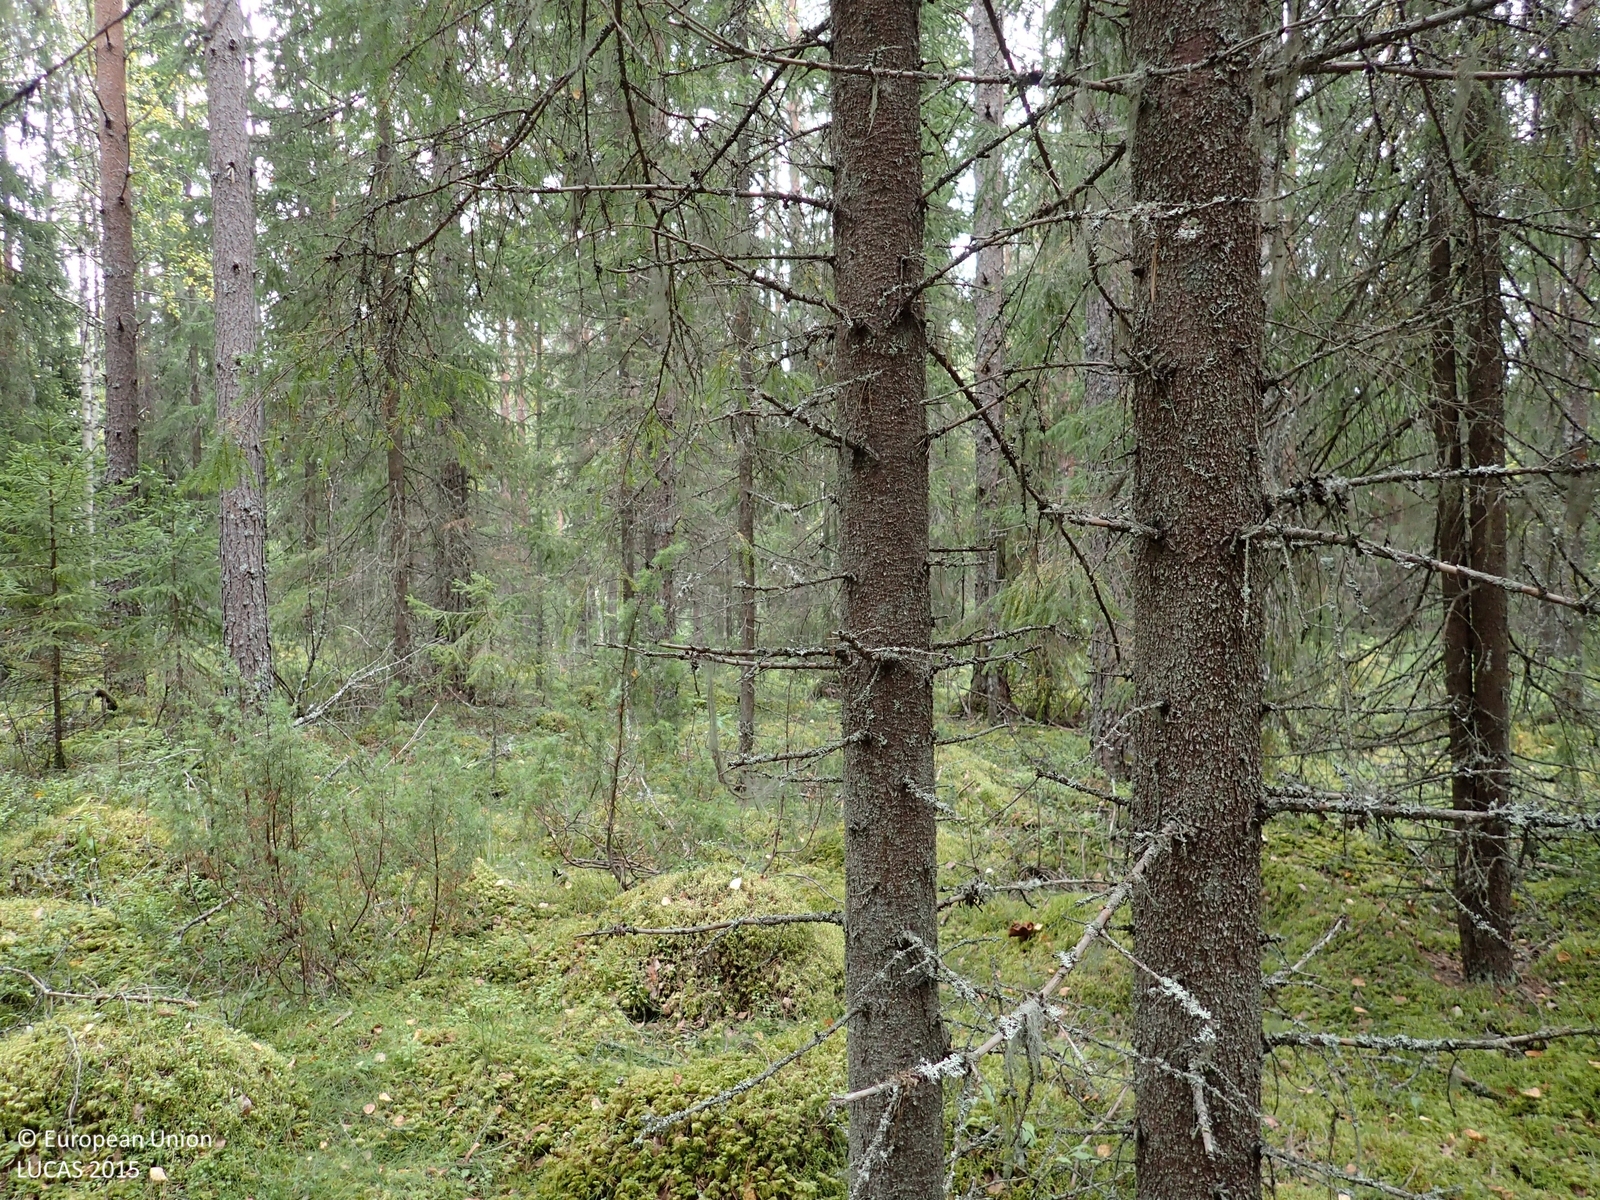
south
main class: Woodland
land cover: Other coniferous woodland
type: boreal forest
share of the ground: > 75 %
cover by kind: coniferous forest trees 70 %, broadleaved forest trees 10 %, shrubs 10 %, lichens and mosses 10 %
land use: Forestry
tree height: > 5 m
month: September
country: FI
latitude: 62.9616
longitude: 25.7089
